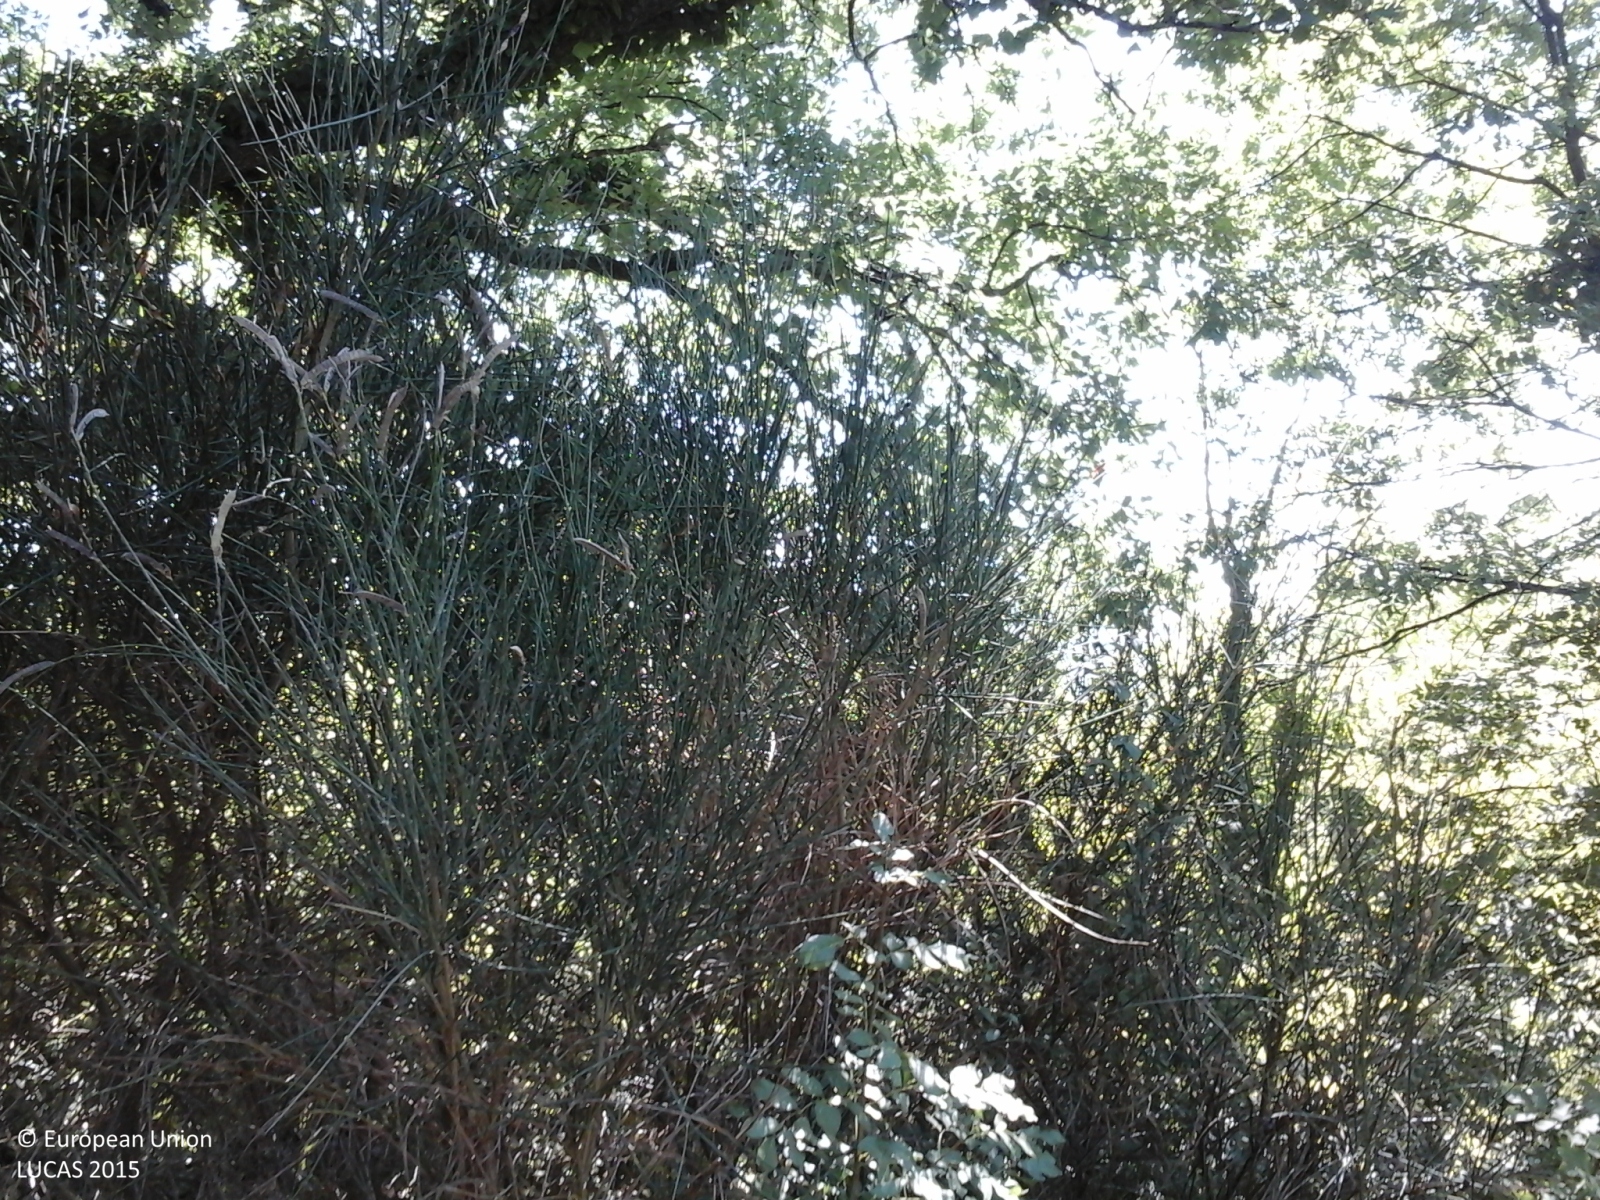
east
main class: Woodland
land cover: Broadleaved woodland
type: thermophilous deciduous forest
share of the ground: > 75 %
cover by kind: broadleaved forest trees 95 %, coniferous forest trees 5 %
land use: Forestry
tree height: > 5 m
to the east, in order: Broadleaved woodland; Tracks; Broadleaved woodland
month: August
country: IT
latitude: 43.1876
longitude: 13.0063
